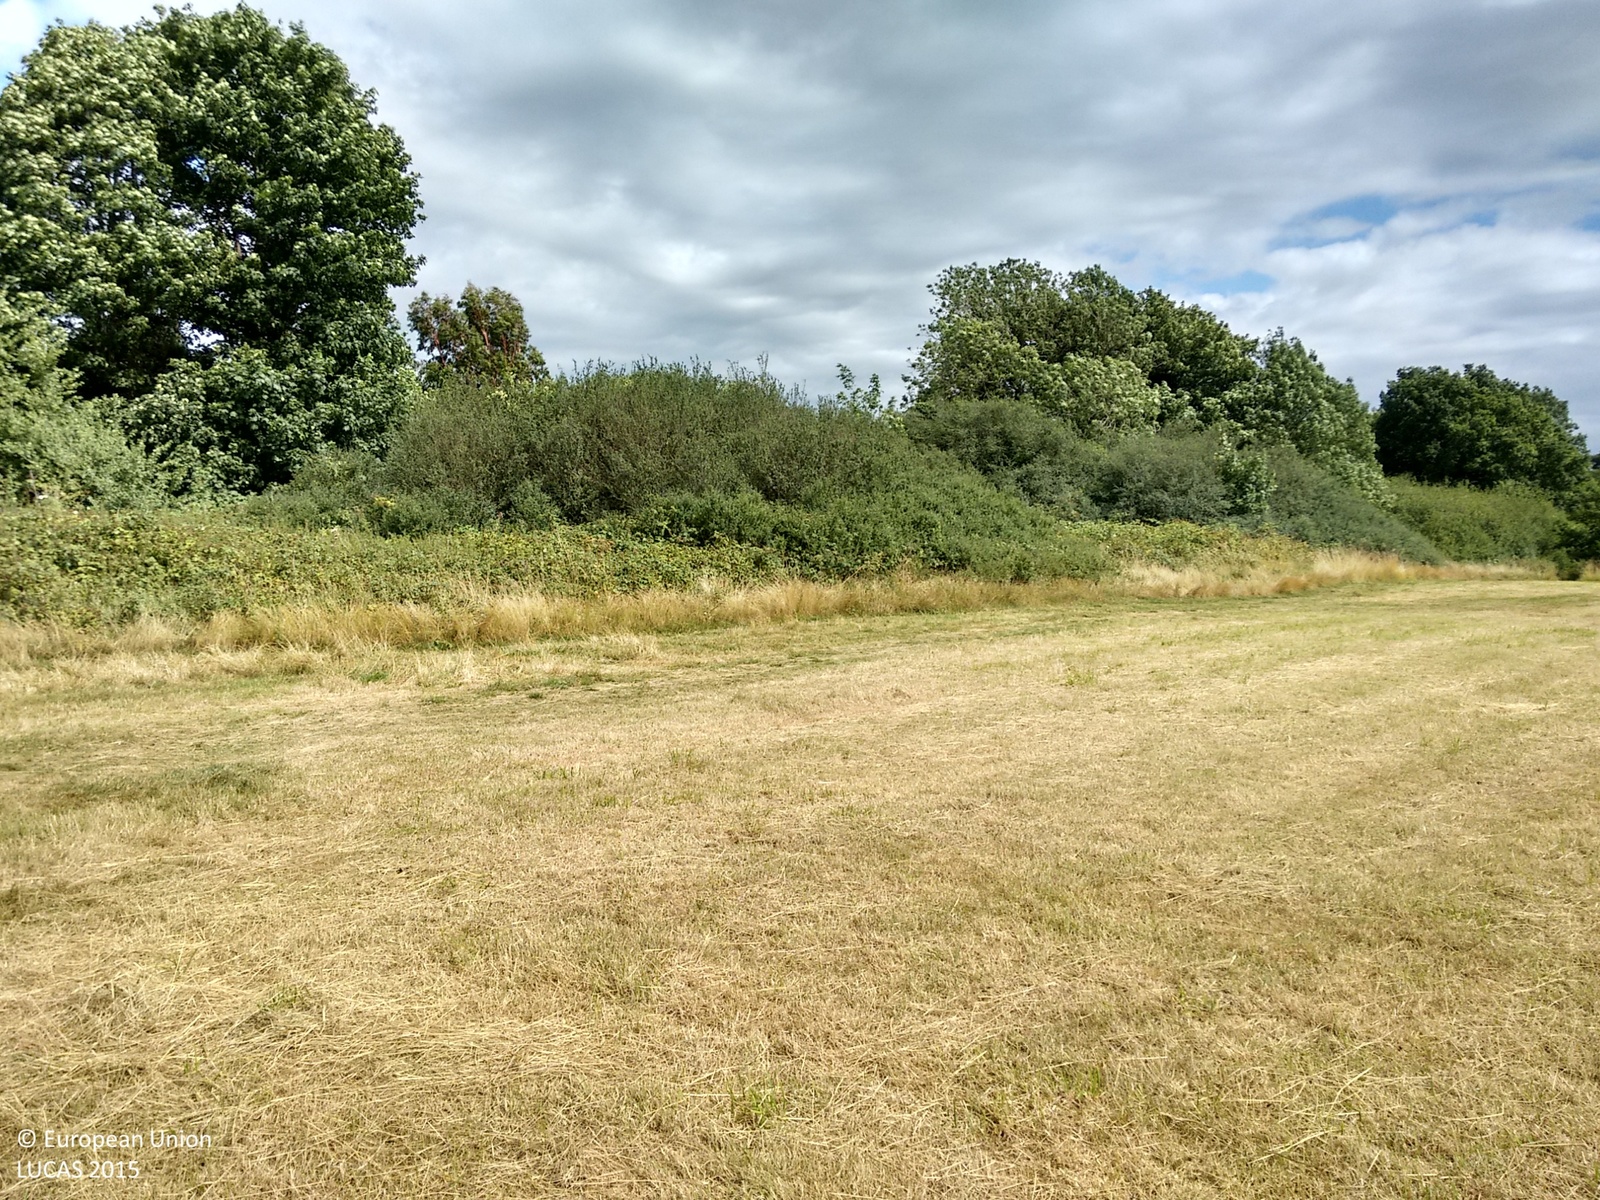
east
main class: Grassland
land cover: Grassland without tree/shrub cover
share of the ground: > 75 %
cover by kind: herbaceous plants 100 %
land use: Amenities, museums, leisure
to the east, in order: Grassland without tree/shrub cover; Shrubland with sparse tree cover; Artificial constructions in urban areas; Broadleaved woodland
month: August
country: GB
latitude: 51.3225
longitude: -0.1800
